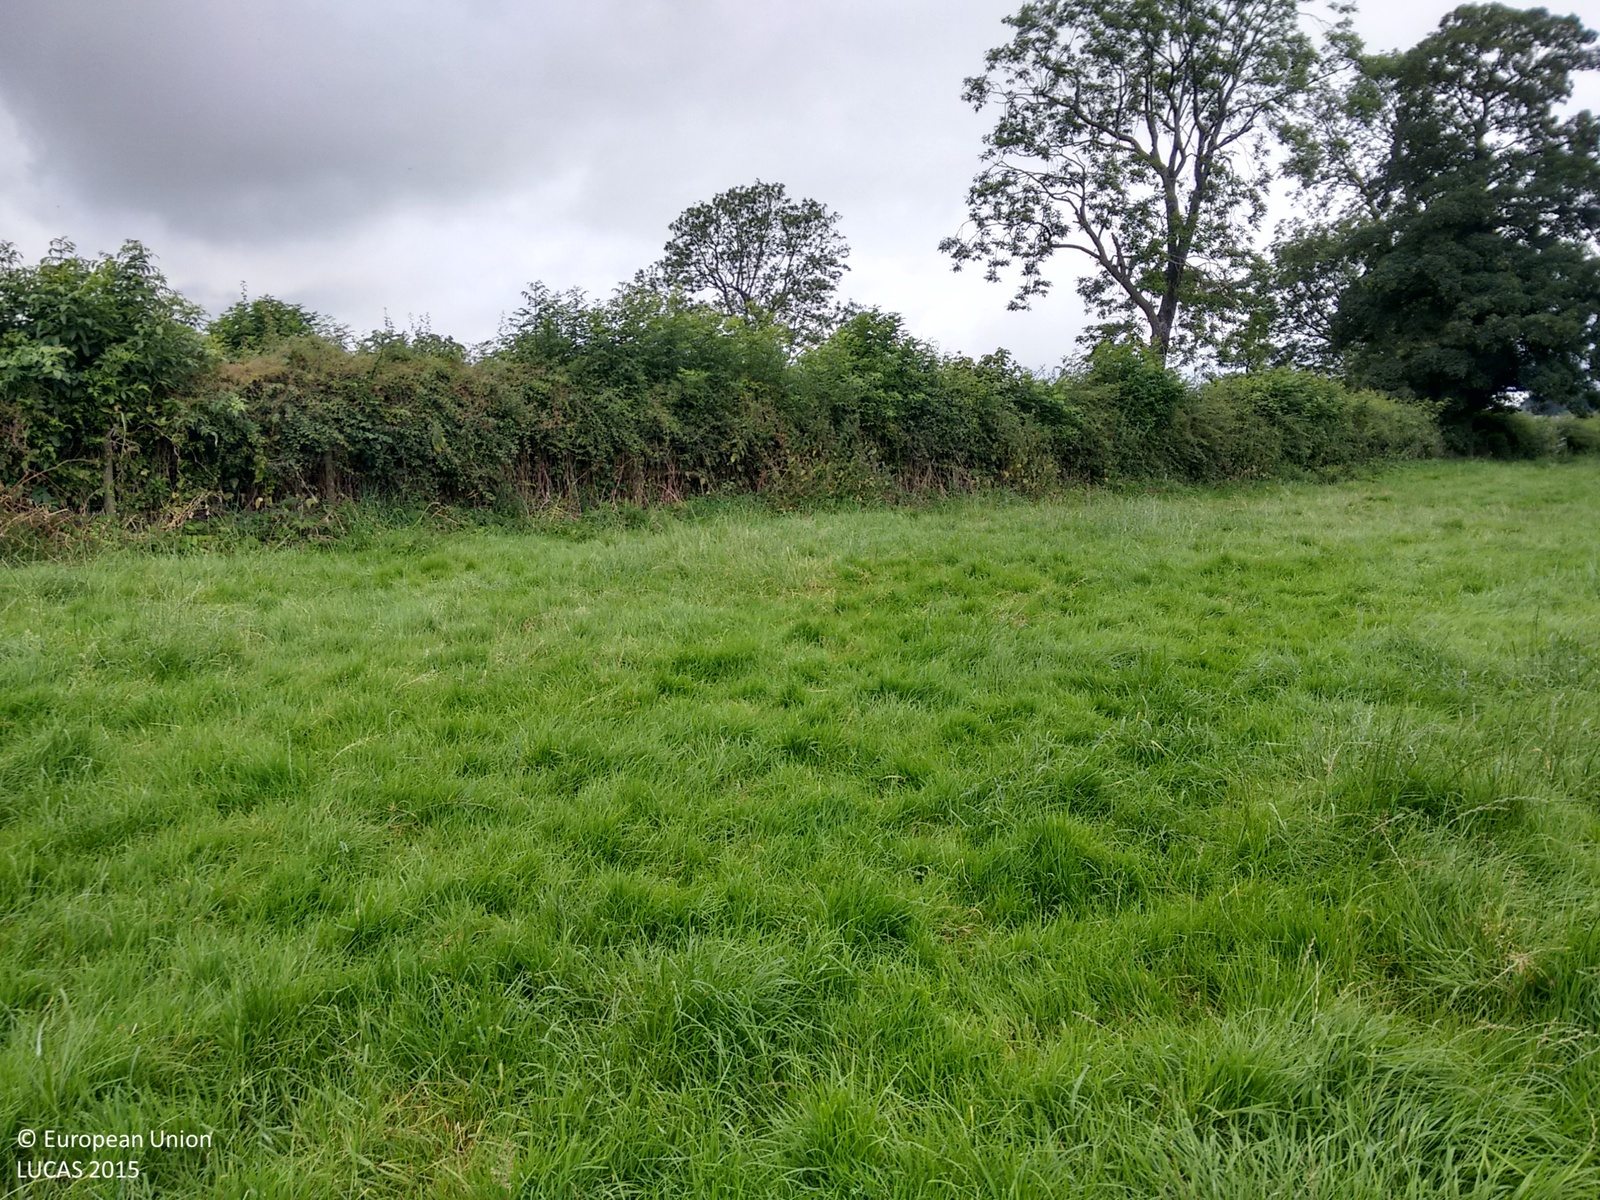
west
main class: Grassland
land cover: Grassland without tree/shrub cover
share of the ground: > 75 %
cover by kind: herbaceous plants 100 %
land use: Agriculture (excluding fallow land and kitchen gardens)
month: August
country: GB
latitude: 54.7152
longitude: -2.8763
